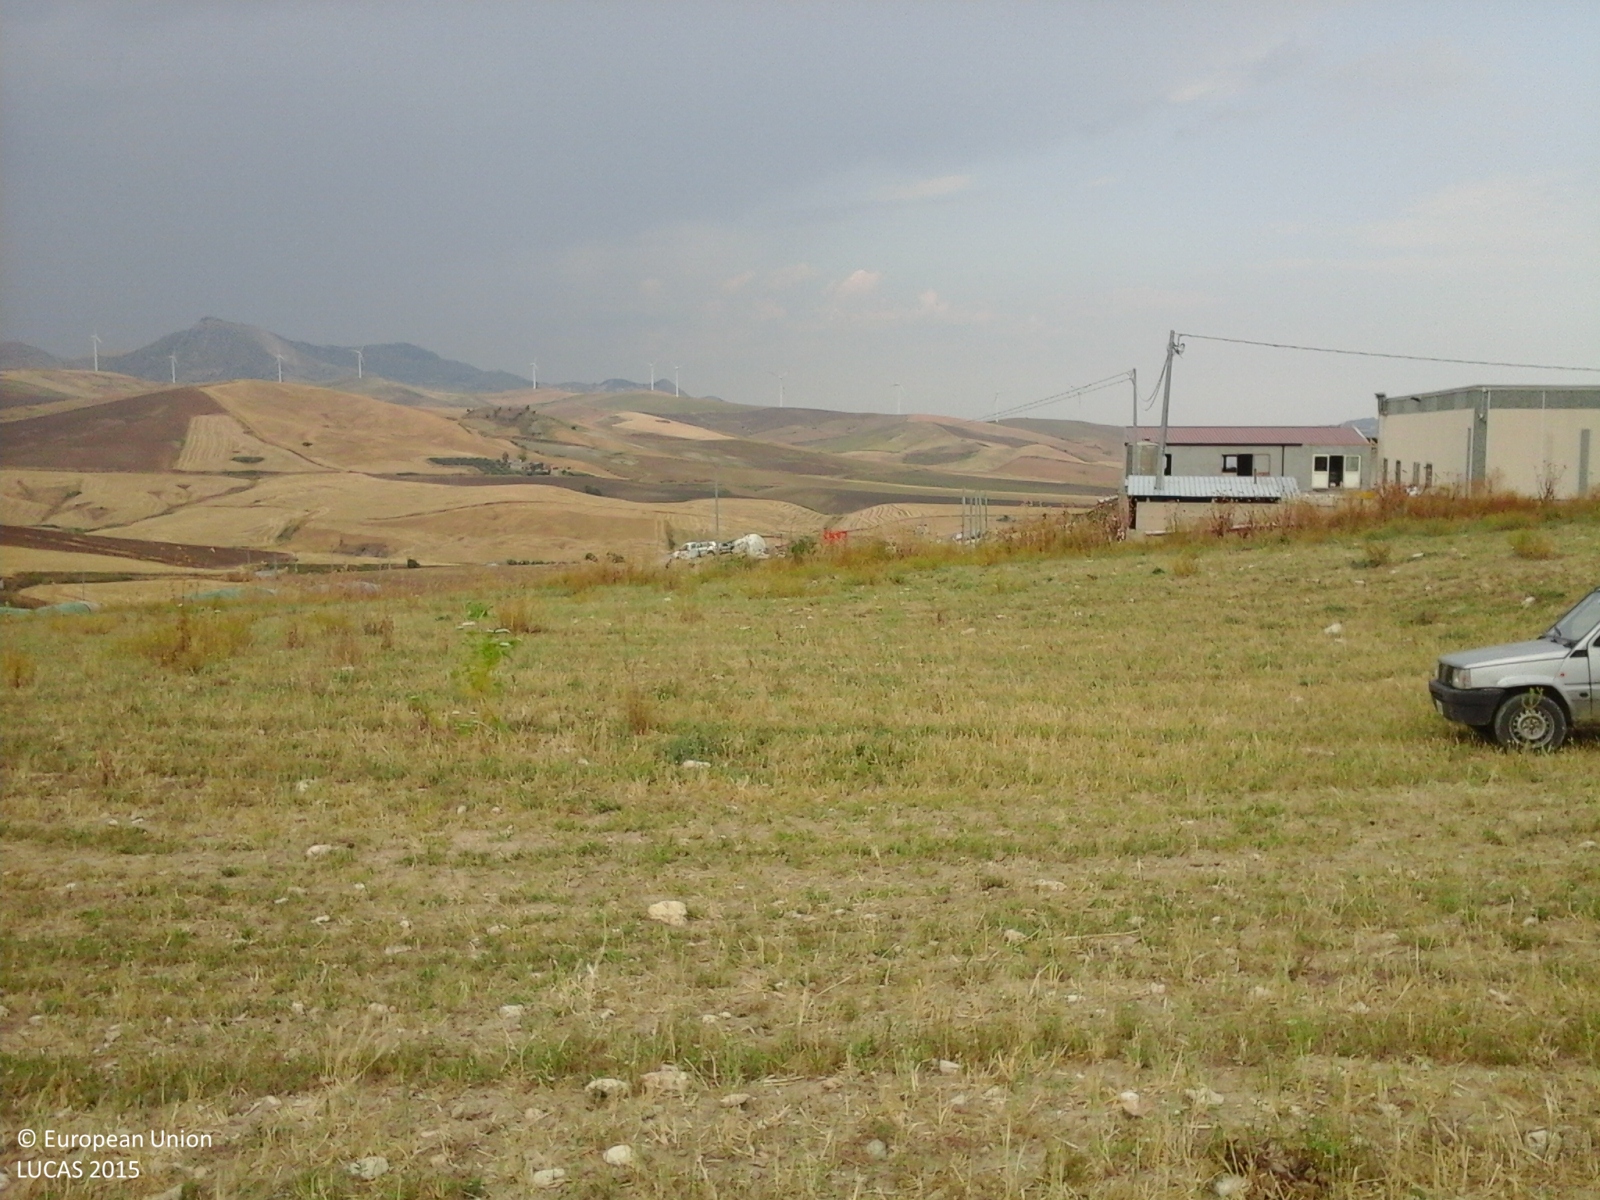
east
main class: Cropland
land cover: Other leguminous and mixtures for fodder
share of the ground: > 75 %
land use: Agriculture (excluding fallow land and kitchen gardens)
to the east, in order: Other leguminous and mixtures for fodder; Grass margins; Ditches and canals; Grass margins; Artificial constructions in urban areas; Grass margins; Durum wheat
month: June
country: IT
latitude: 37.4741
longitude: 14.5686
